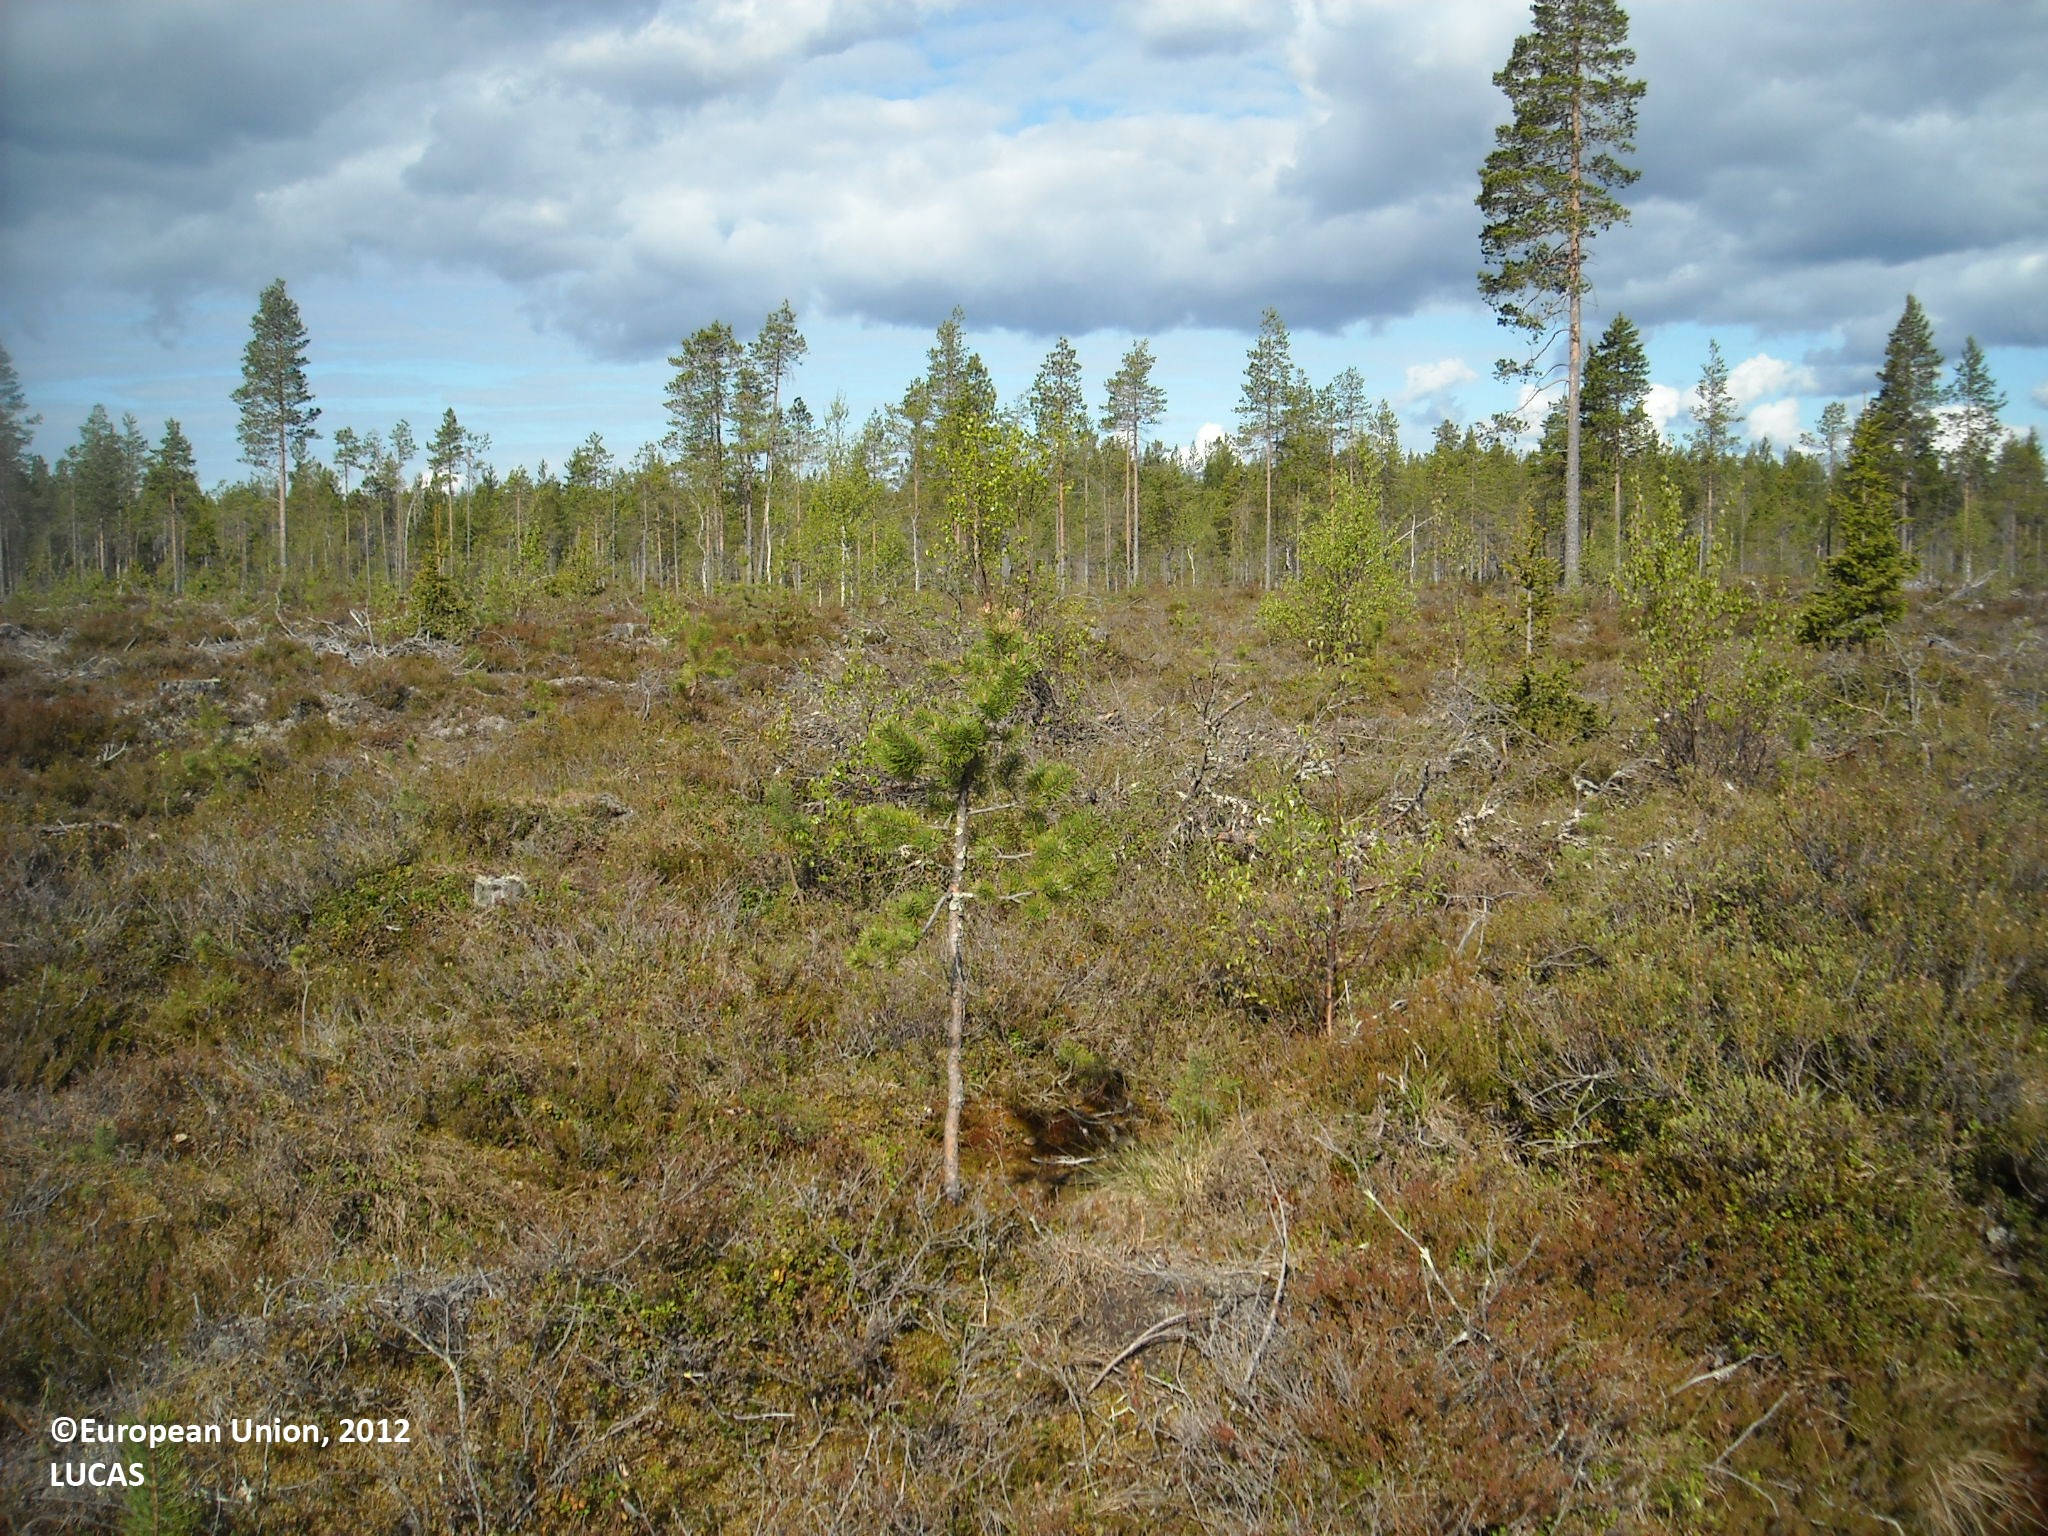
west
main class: Shrubland
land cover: Shrubland with sparse tree cover
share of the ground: > 75 %
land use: Forestry
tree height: < 5 m
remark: Clear cut
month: May
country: FI
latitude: 64.7565
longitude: 27.3035
